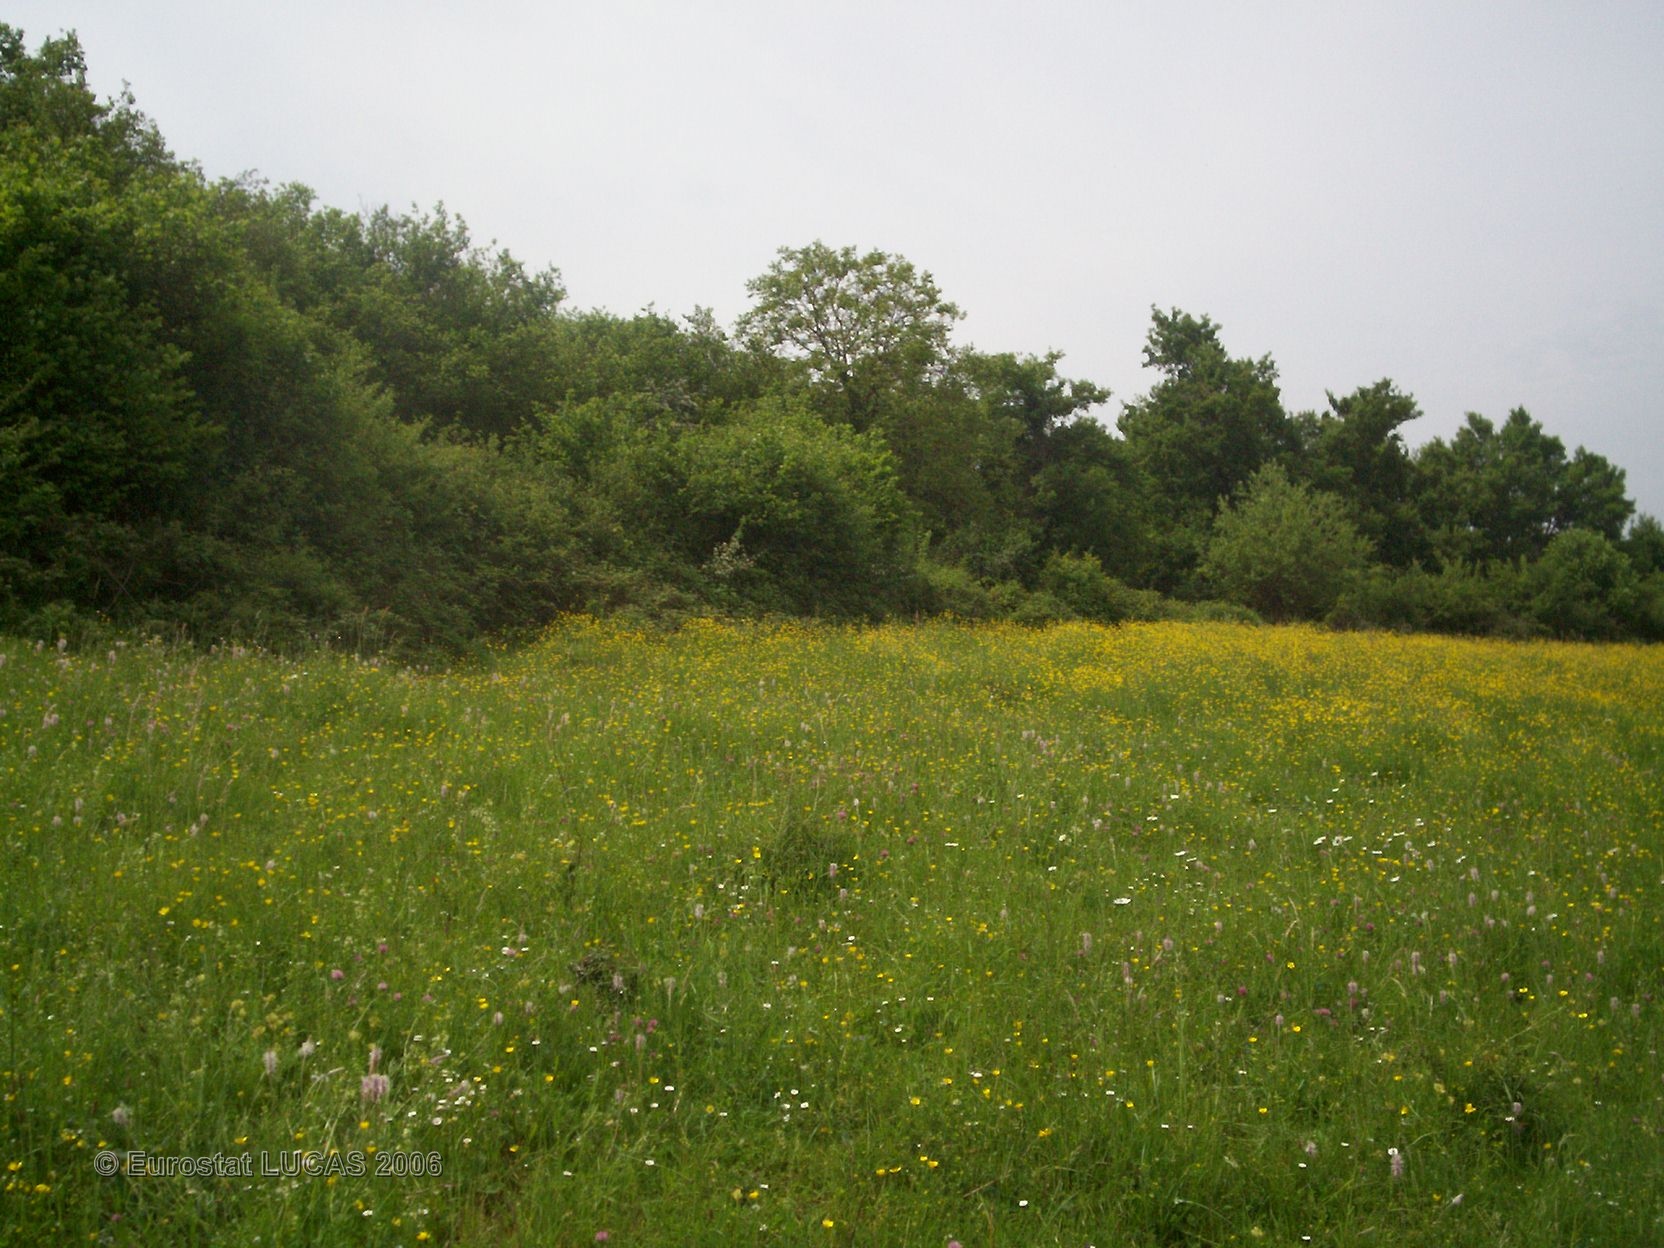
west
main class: Grassland
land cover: Grassland without tree/shrub cover
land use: Agriculture (excluding fallow land and kitchen gardens)
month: May
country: FR
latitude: 46.7240
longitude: 4.6759
